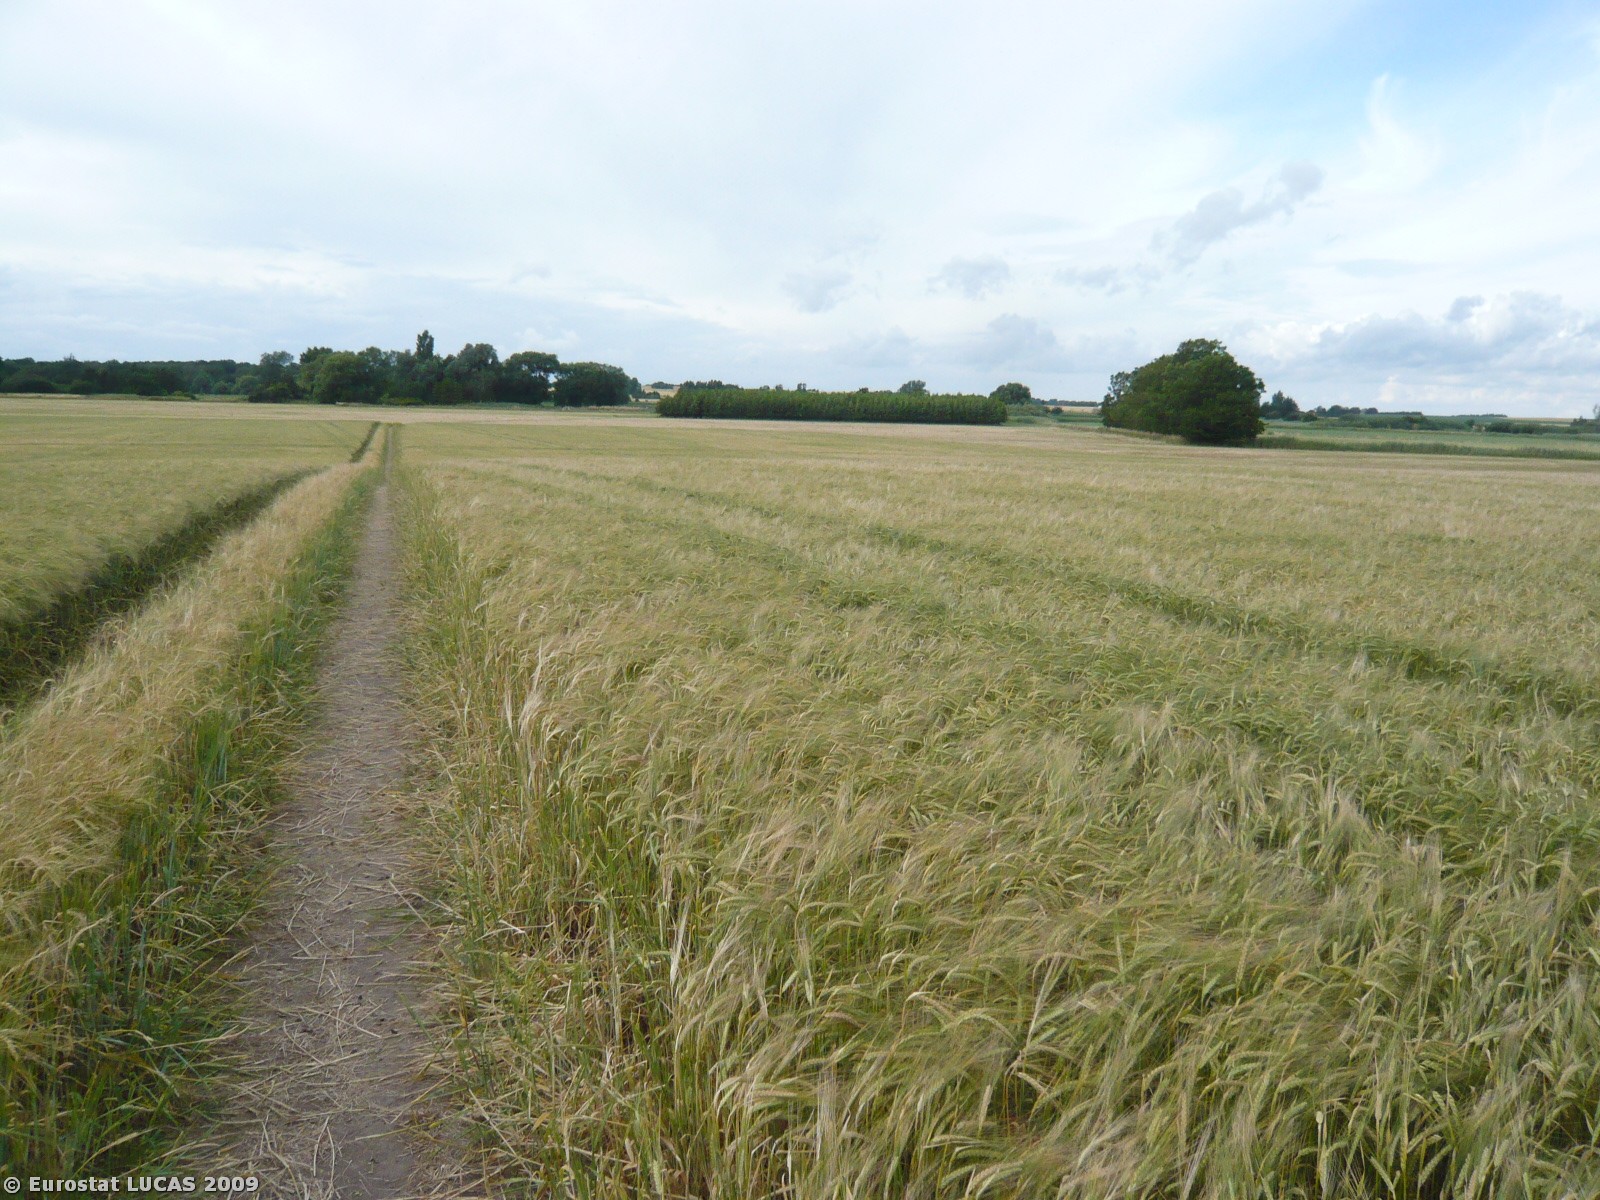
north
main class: Cropland
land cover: Barley
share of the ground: > 75 %
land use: Agriculture (excluding fallow land and kitchen gardens)
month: July
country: DK
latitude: 55.4449
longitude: 11.2162
